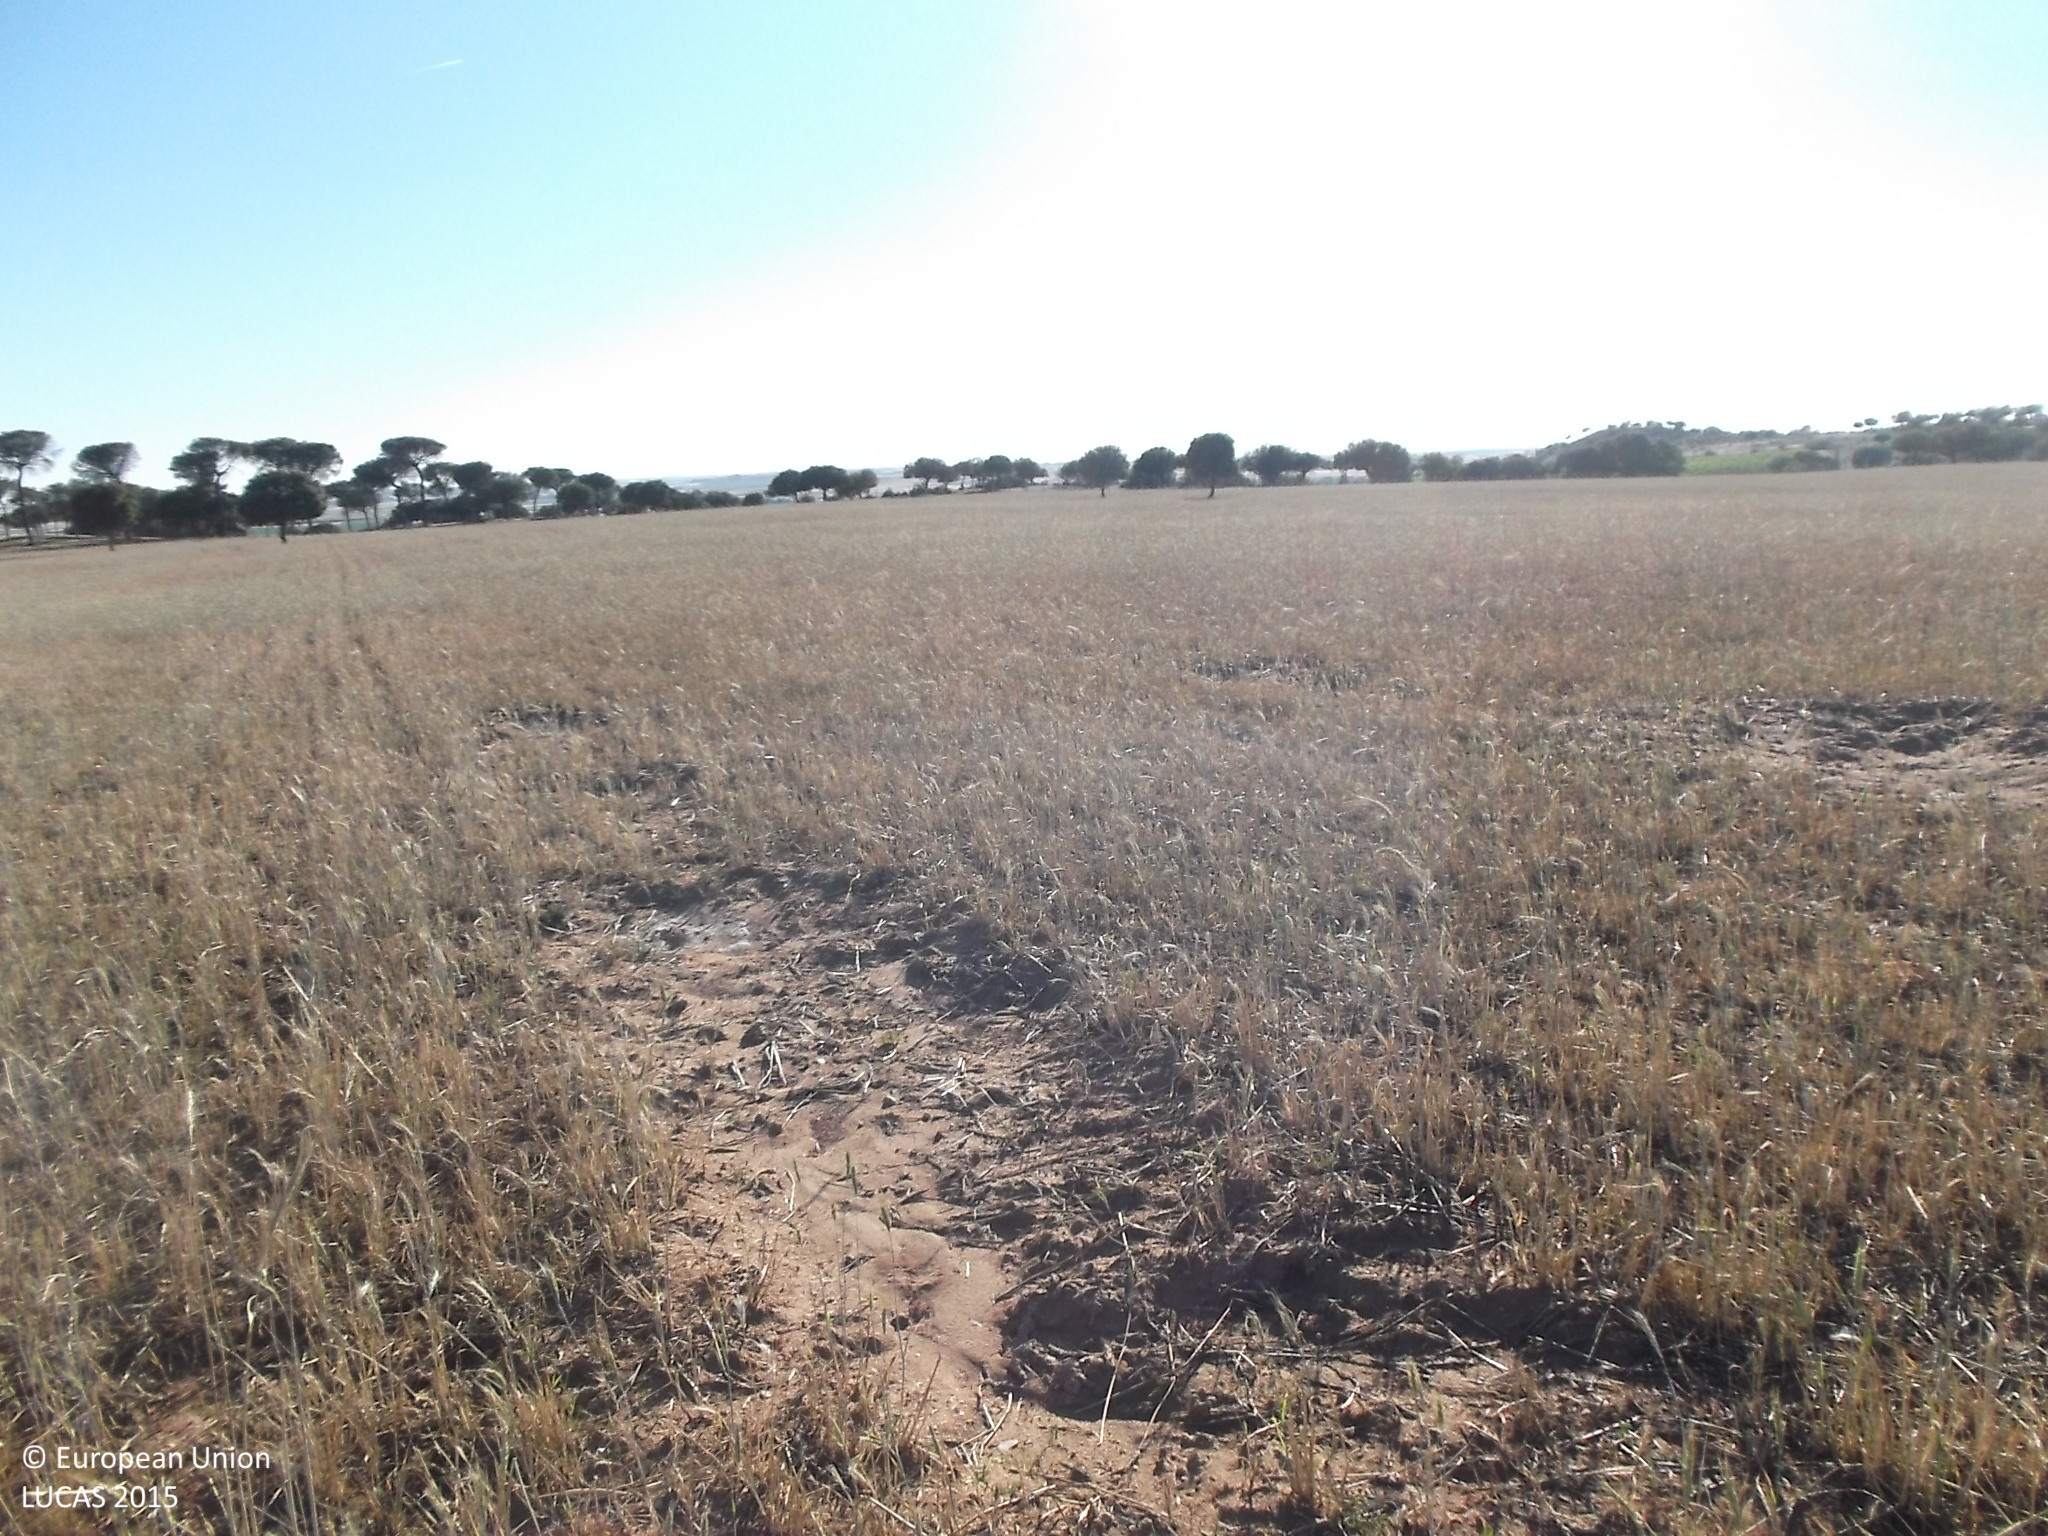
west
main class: Cropland
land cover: Rye
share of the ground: > 75 %
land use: Agriculture (excluding fallow land and kitchen gardens)
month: June
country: ES
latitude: 41.3102
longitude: -5.3533
